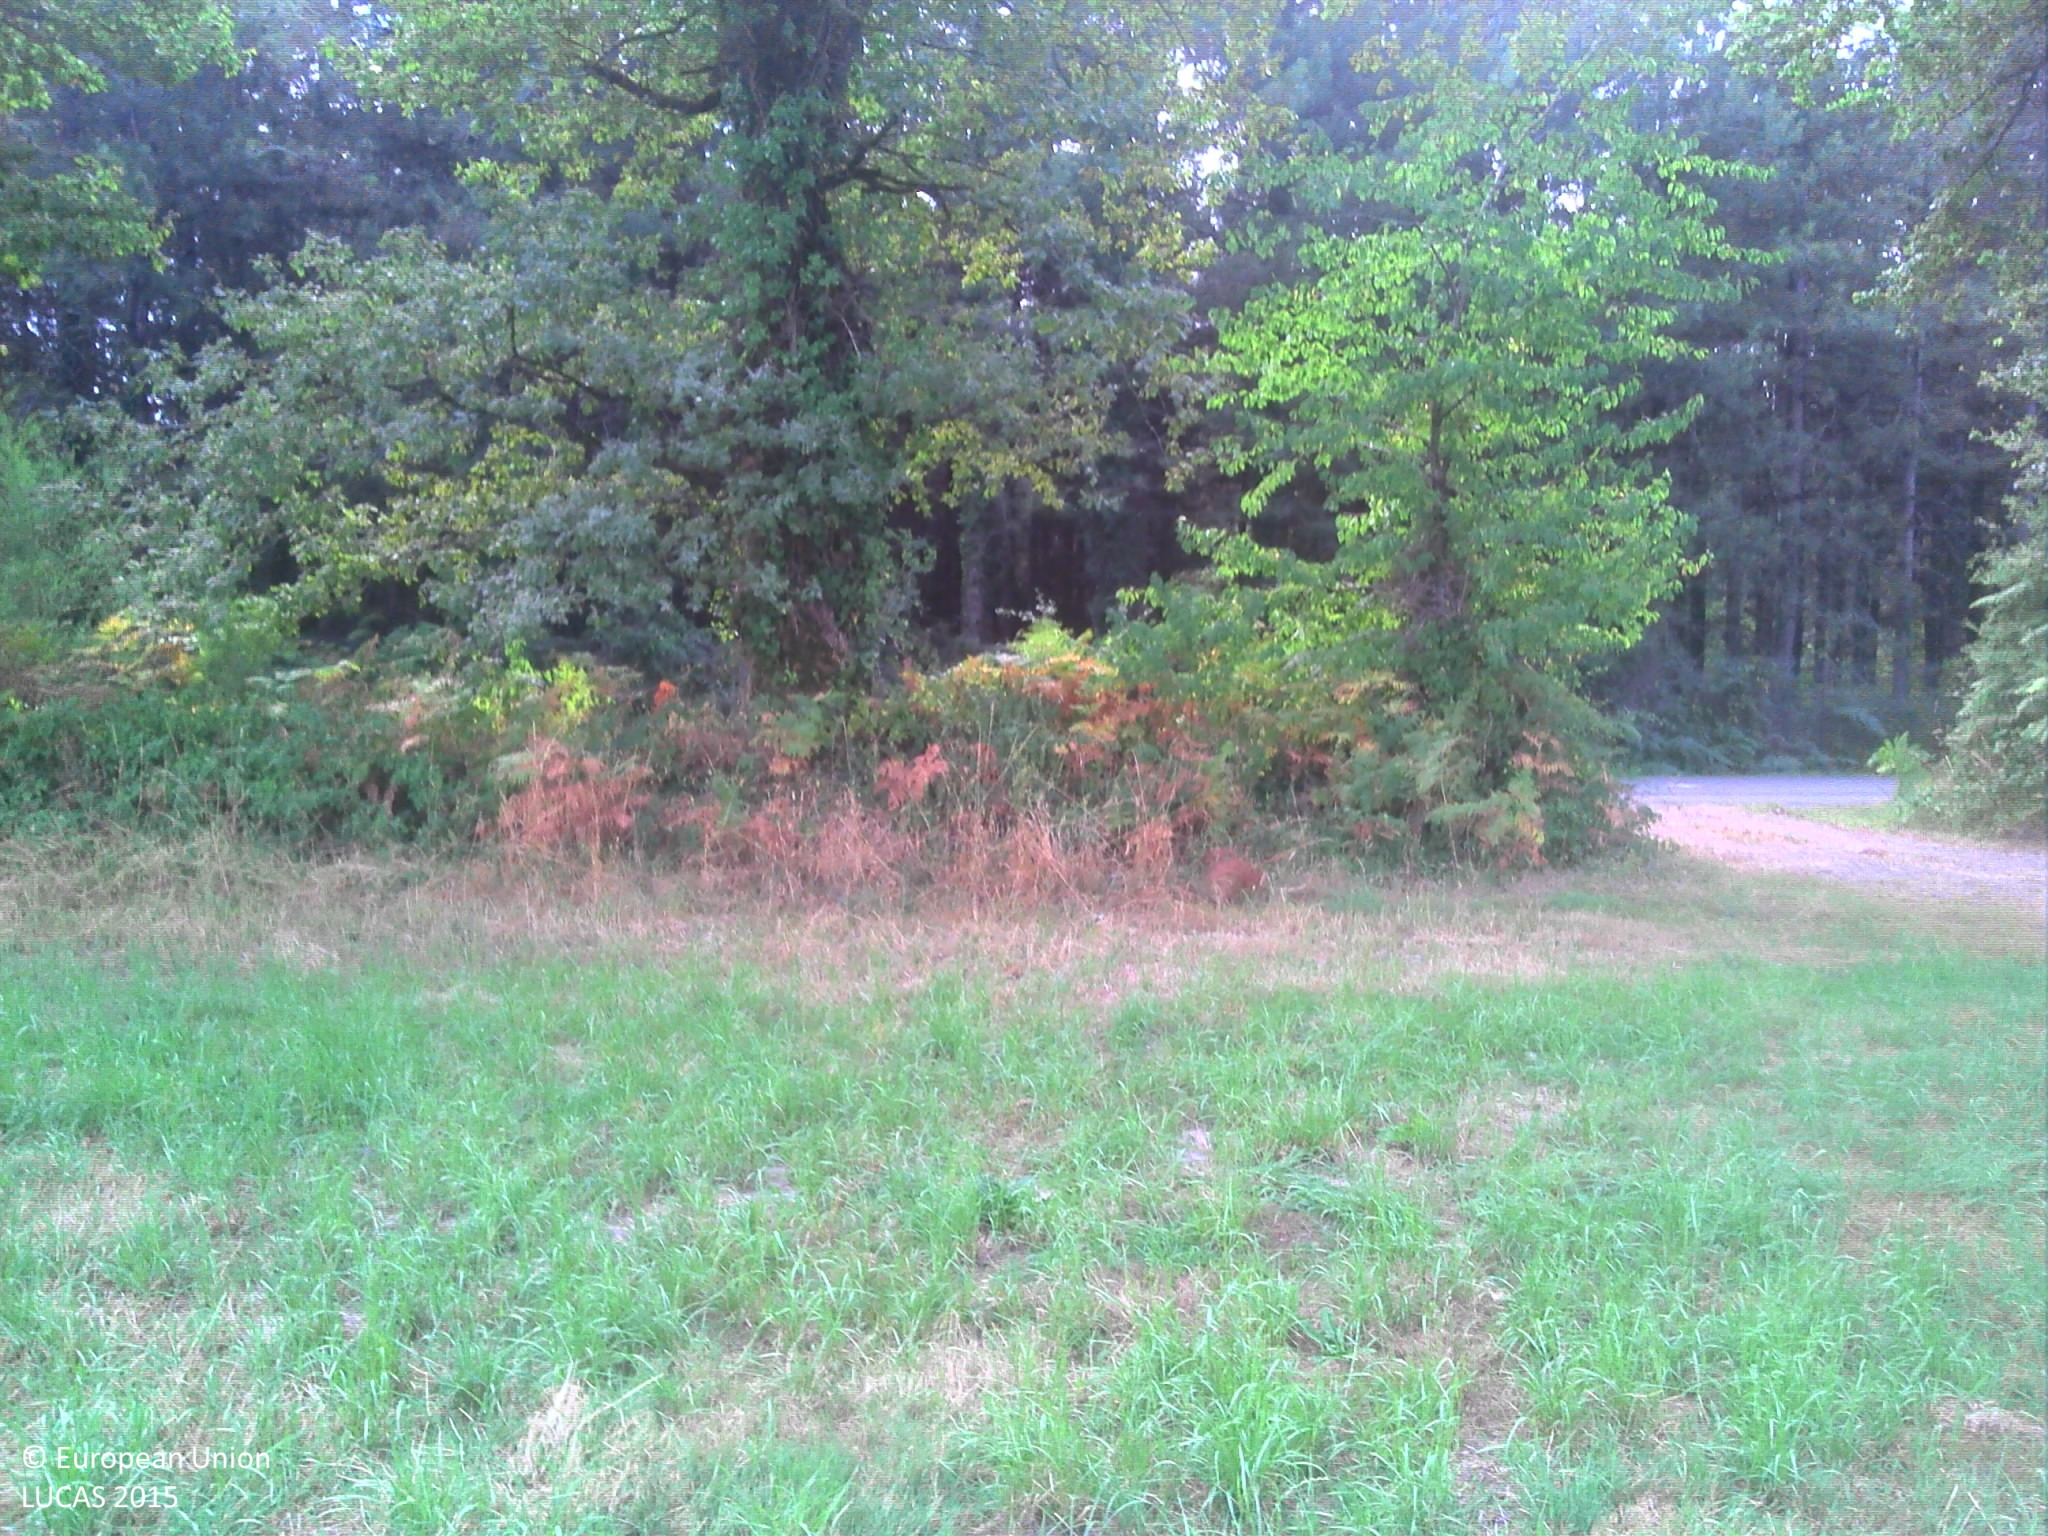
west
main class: Cropland
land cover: Temporary grasslands
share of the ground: > 75 %
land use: Agriculture (excluding fallow land and kitchen gardens)
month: July
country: FR
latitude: 46.4868
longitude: -1.3829
